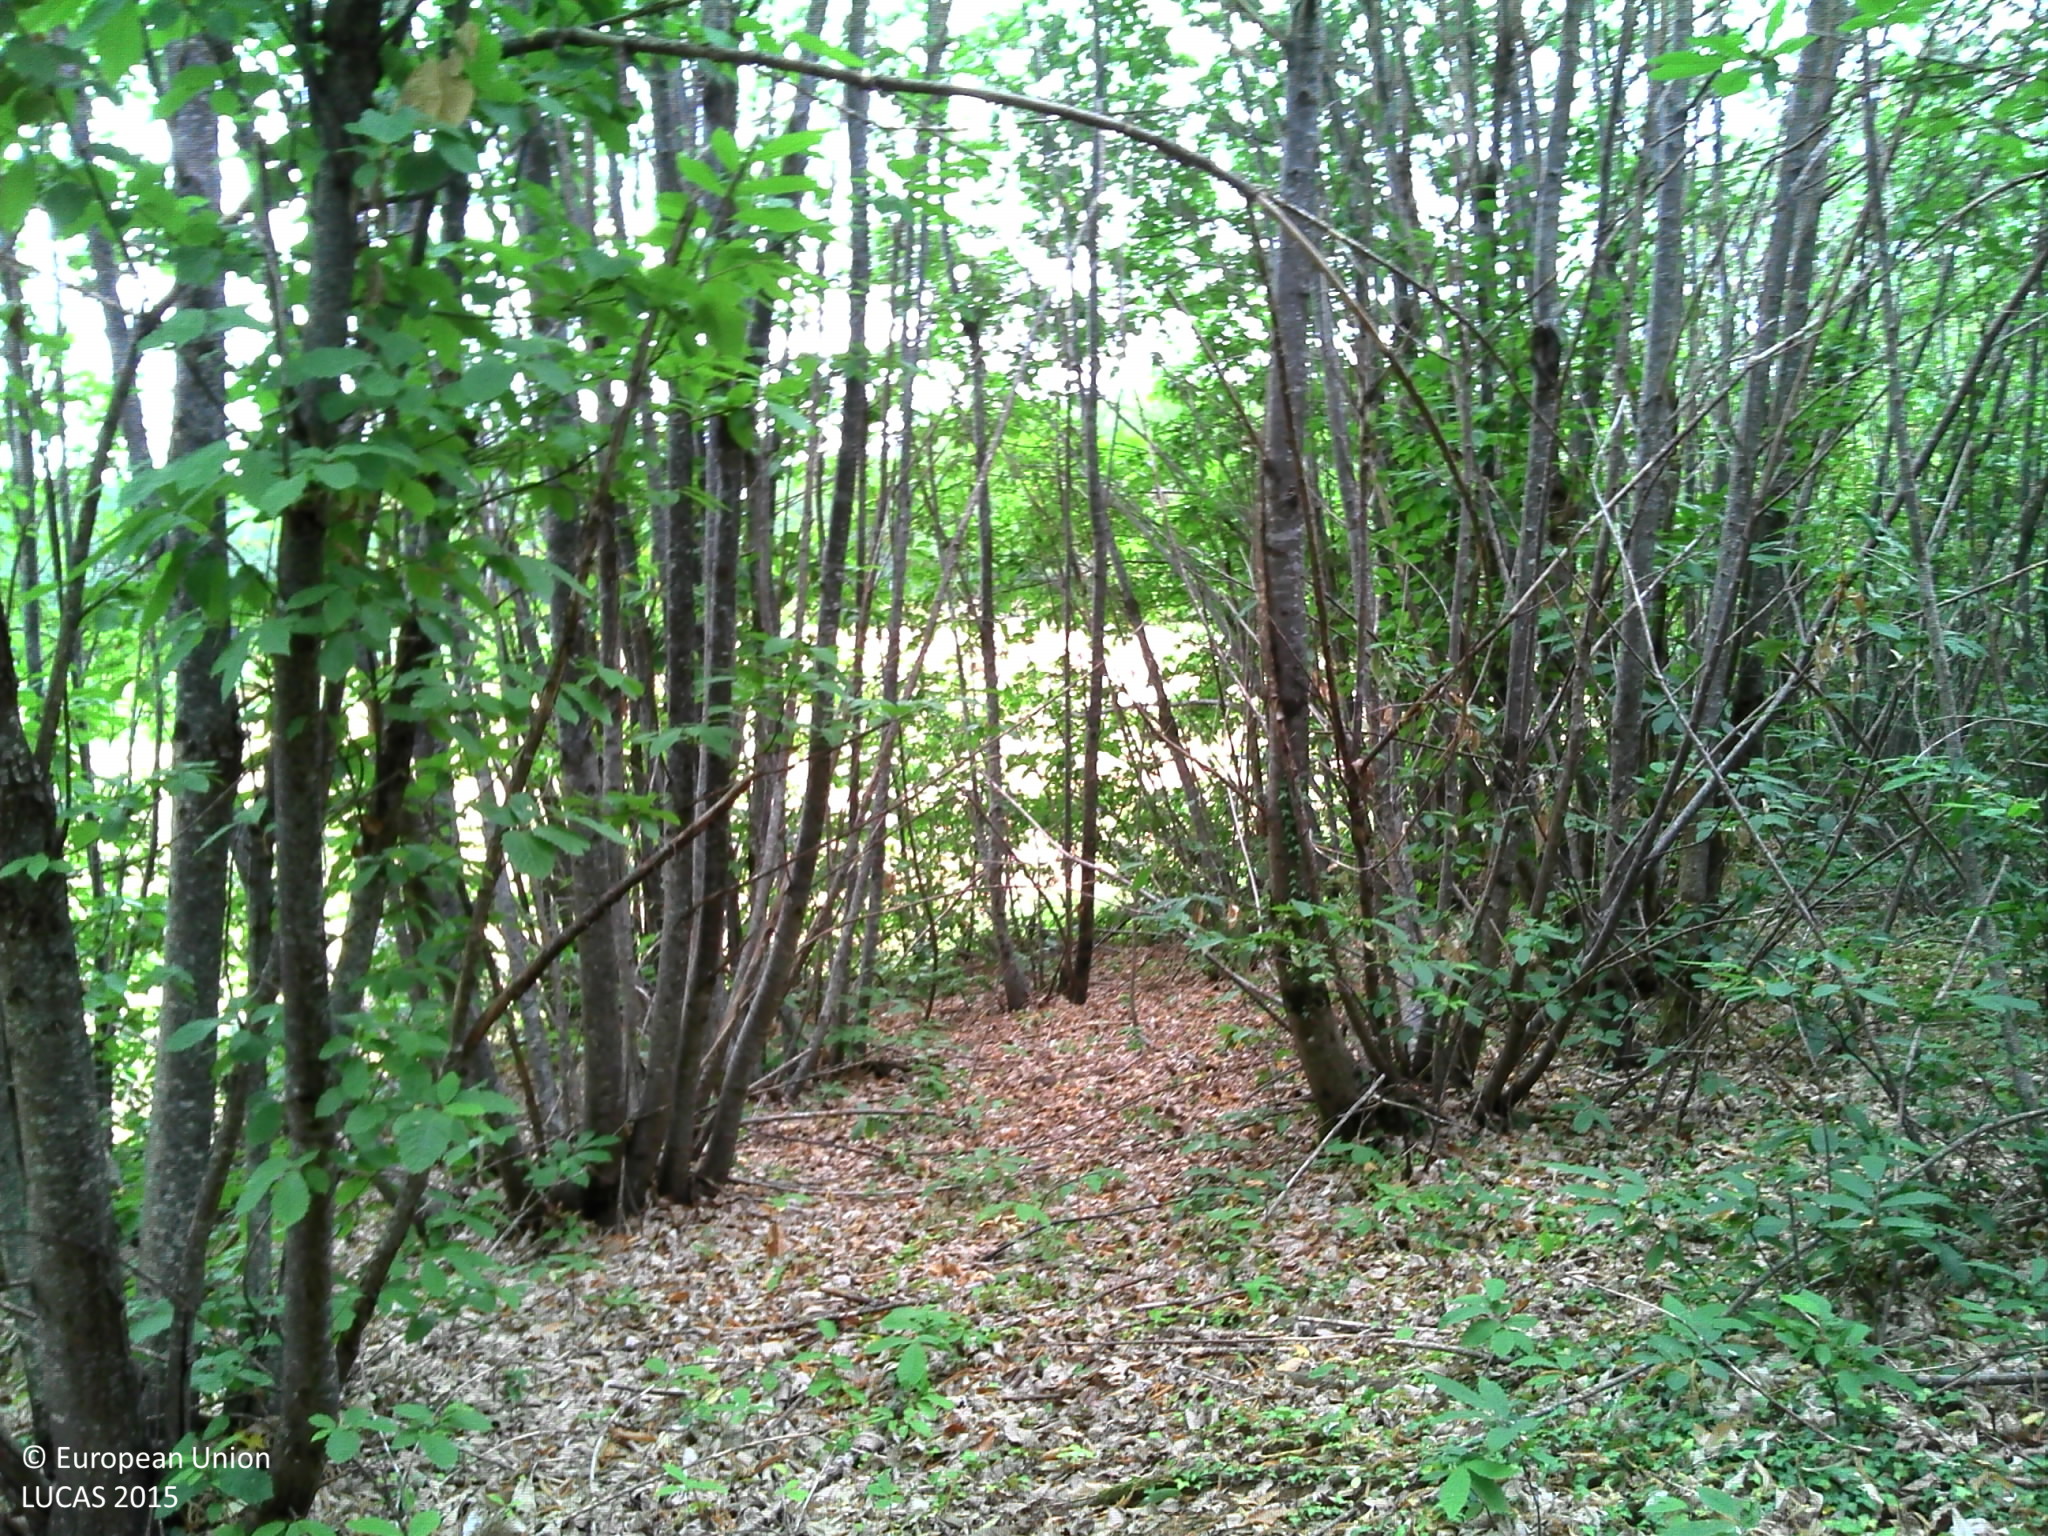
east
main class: Woodland
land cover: Broadleaved woodland
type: thermophilous deciduous forest
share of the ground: > 75 %
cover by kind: broadleaved forest trees 80 %, herbaceous plants 10 %, shrubs 5 %, lichens and mosses 5 %
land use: Forestry
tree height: > 5 m
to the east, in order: Broadleaved woodland; Grass margins; Tracks; Common wheat; Grass margins; Paved roads, cycling and walking lanes; Grass margins; Electric lines; Grass margins; Broadleaved woodland
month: July
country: FR
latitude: 44.9168
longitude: 0.7571
